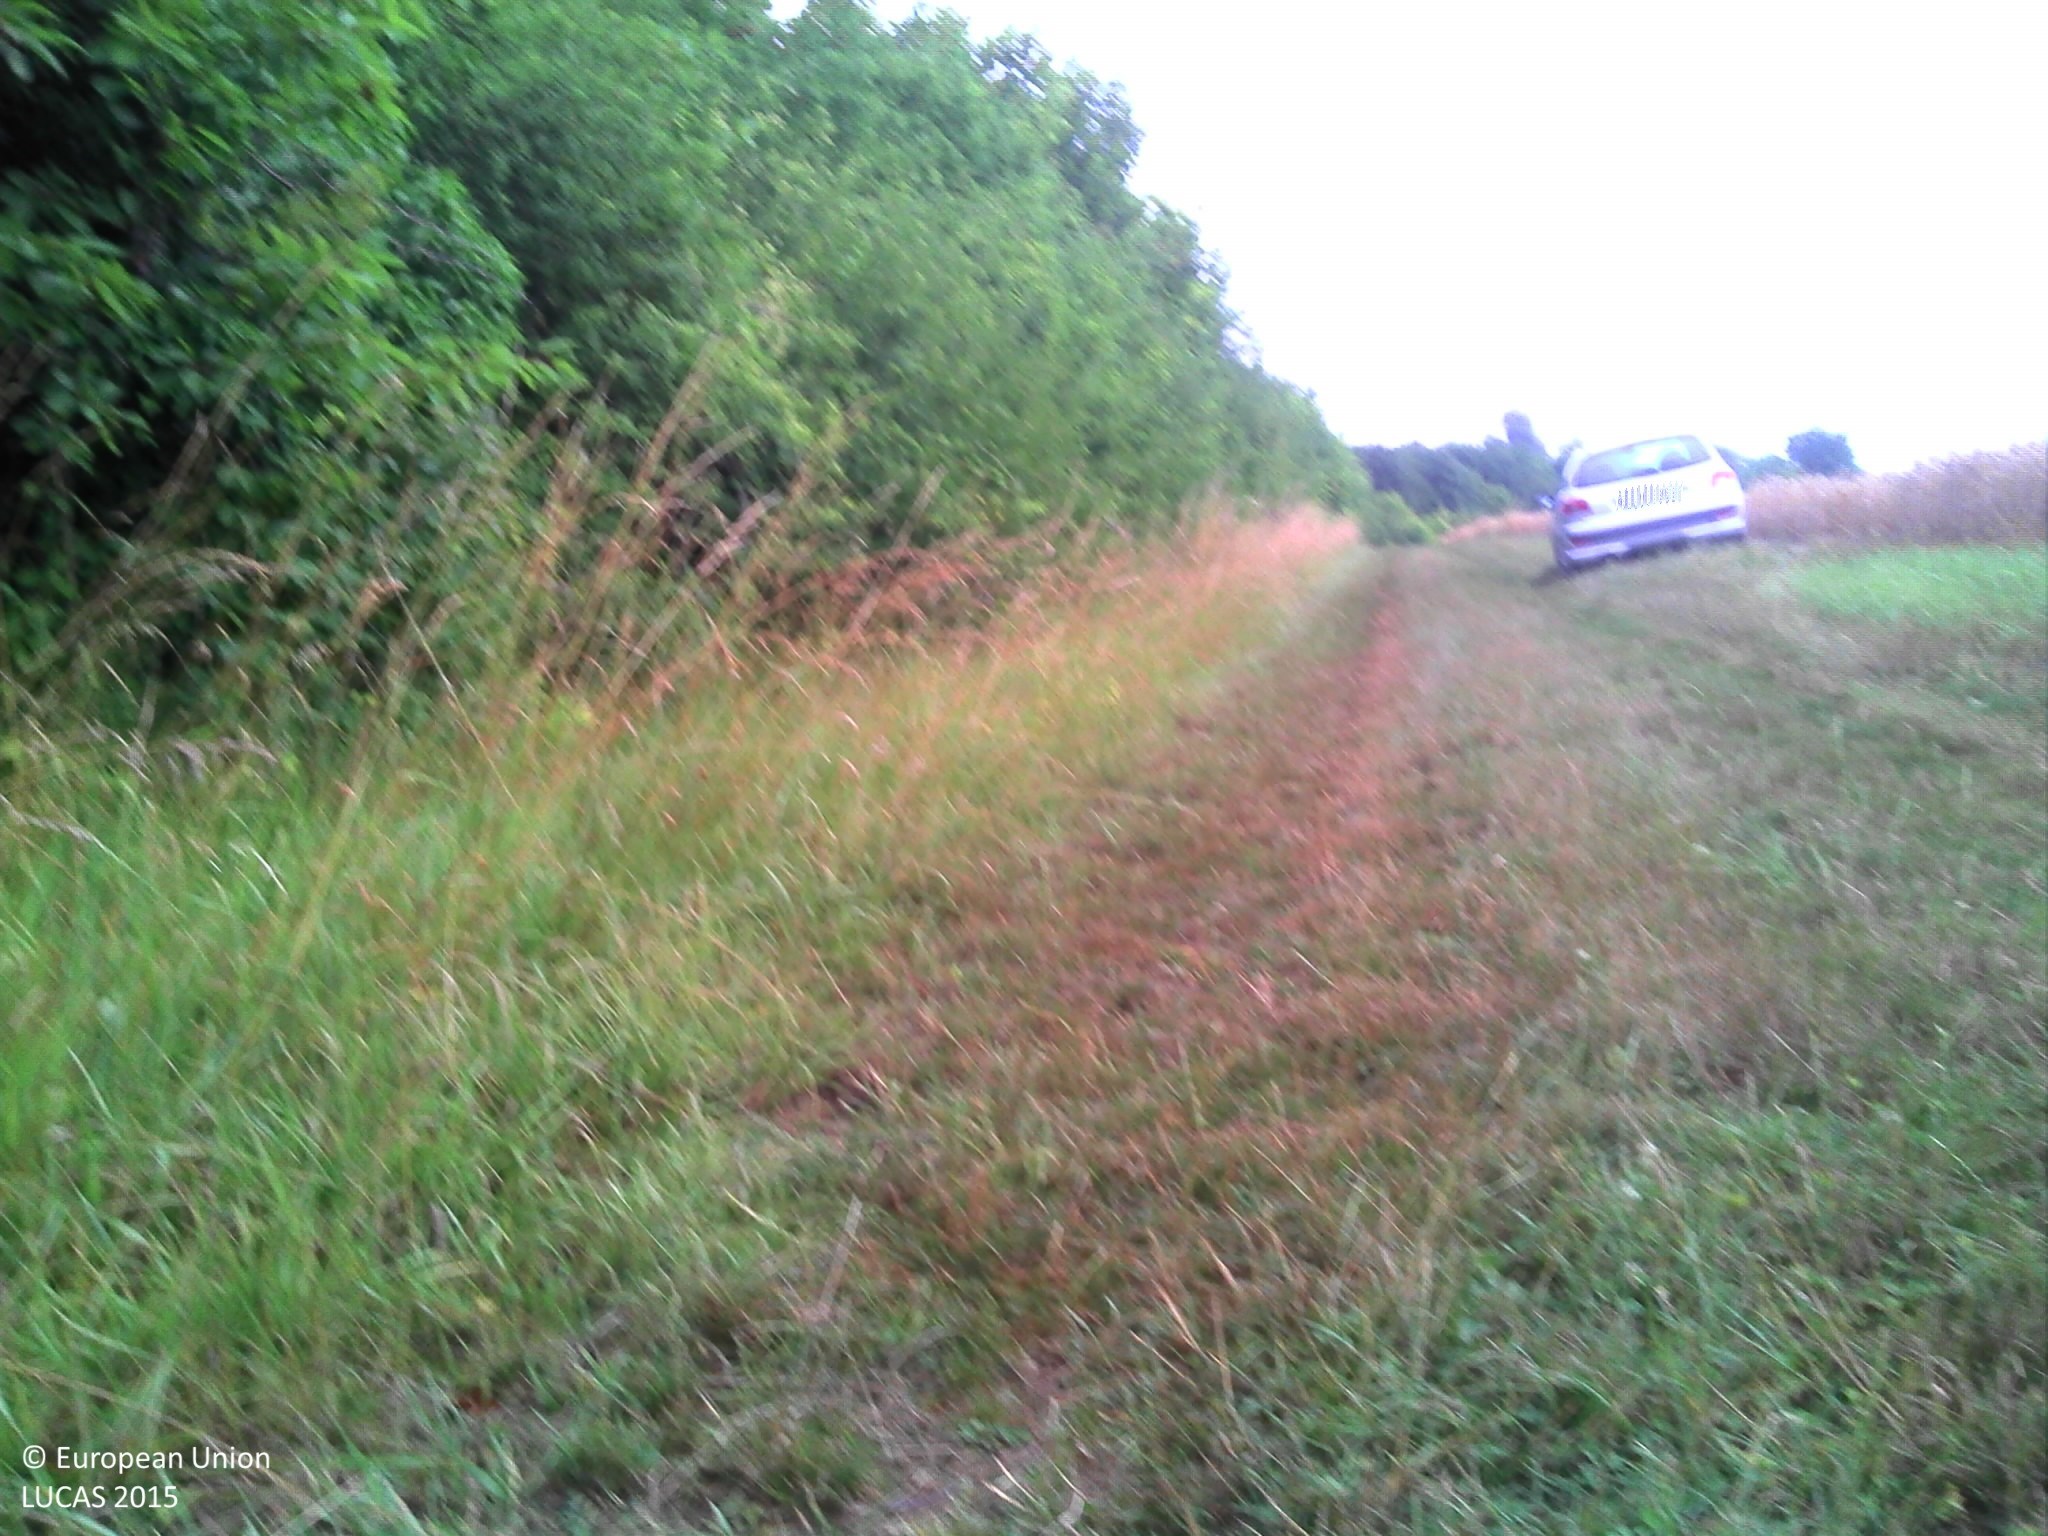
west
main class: Cropland
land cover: Common wheat
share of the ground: > 75 %
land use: Agriculture (excluding fallow land and kitchen gardens)
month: July
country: FR
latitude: 48.7543
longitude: 4.1607
